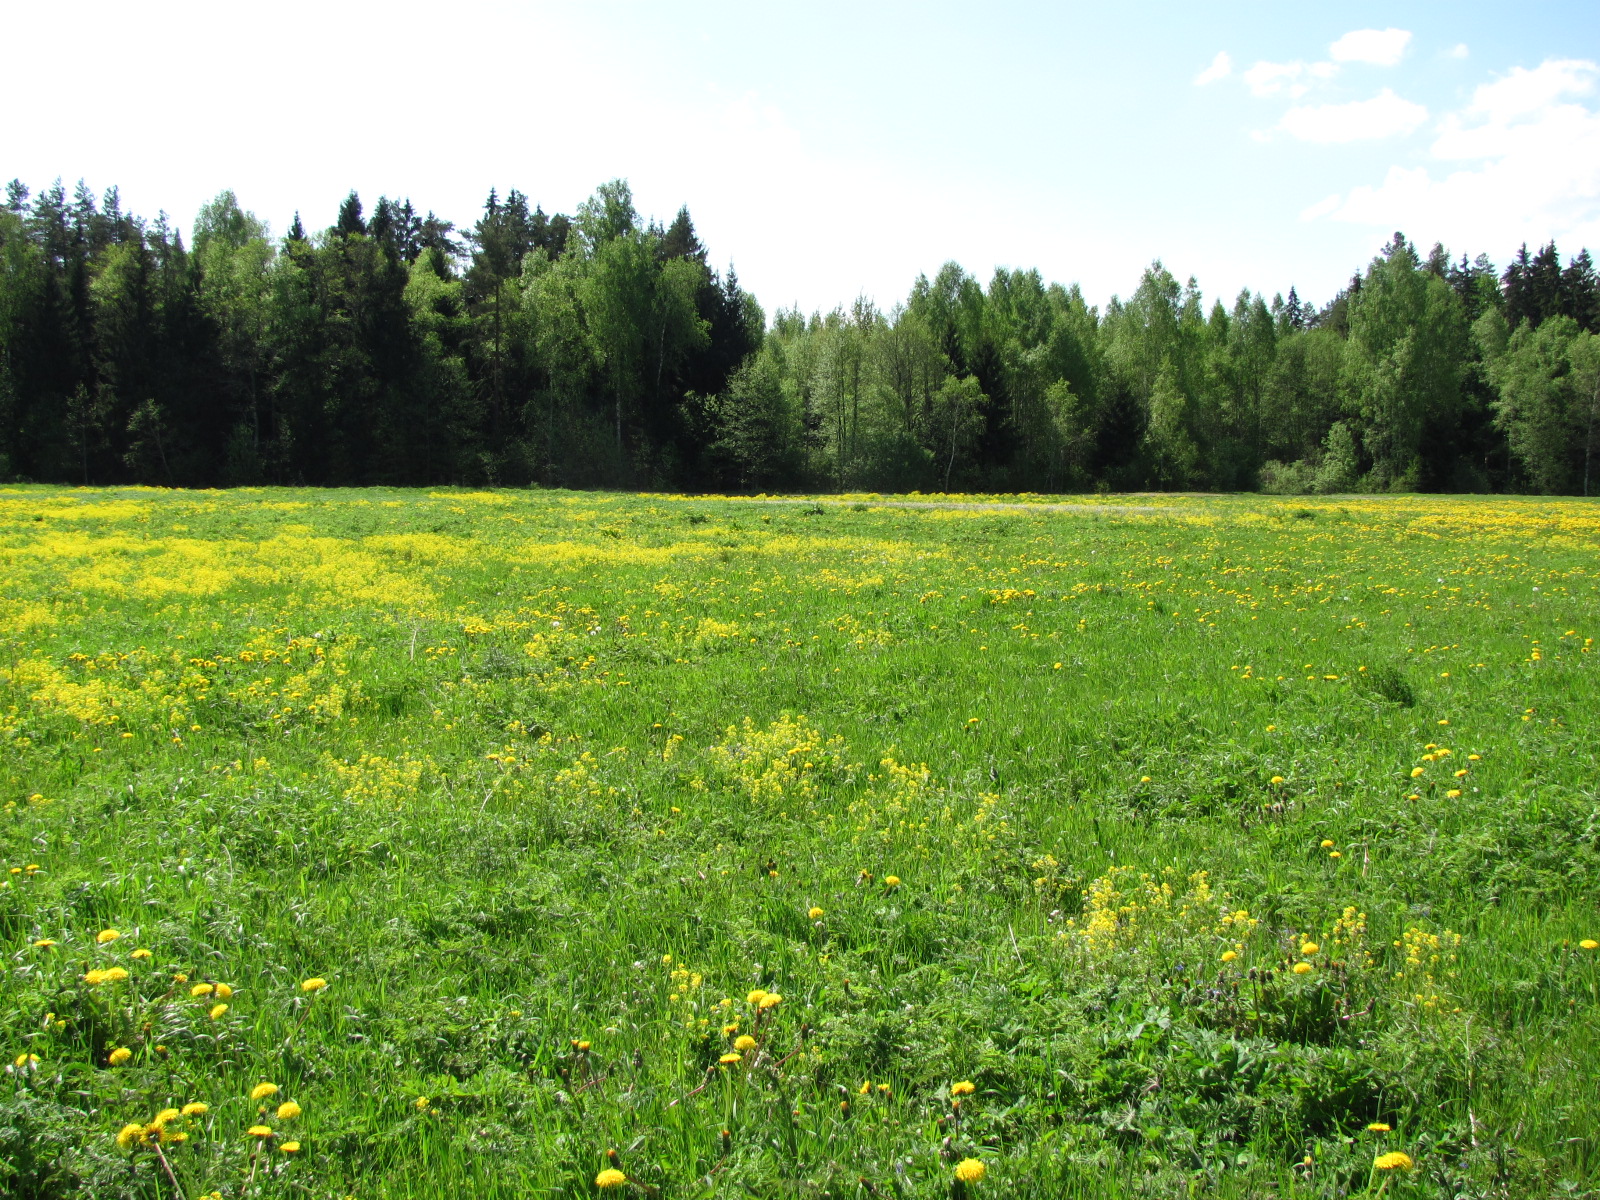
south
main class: Grassland
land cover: Grassland without tree/shrub cover
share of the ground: > 75 %
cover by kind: herbaceous plants 100 %
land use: Agriculture (excluding fallow land and kitchen gardens)
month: May
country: LV
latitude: 56.7951
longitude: 24.4190
